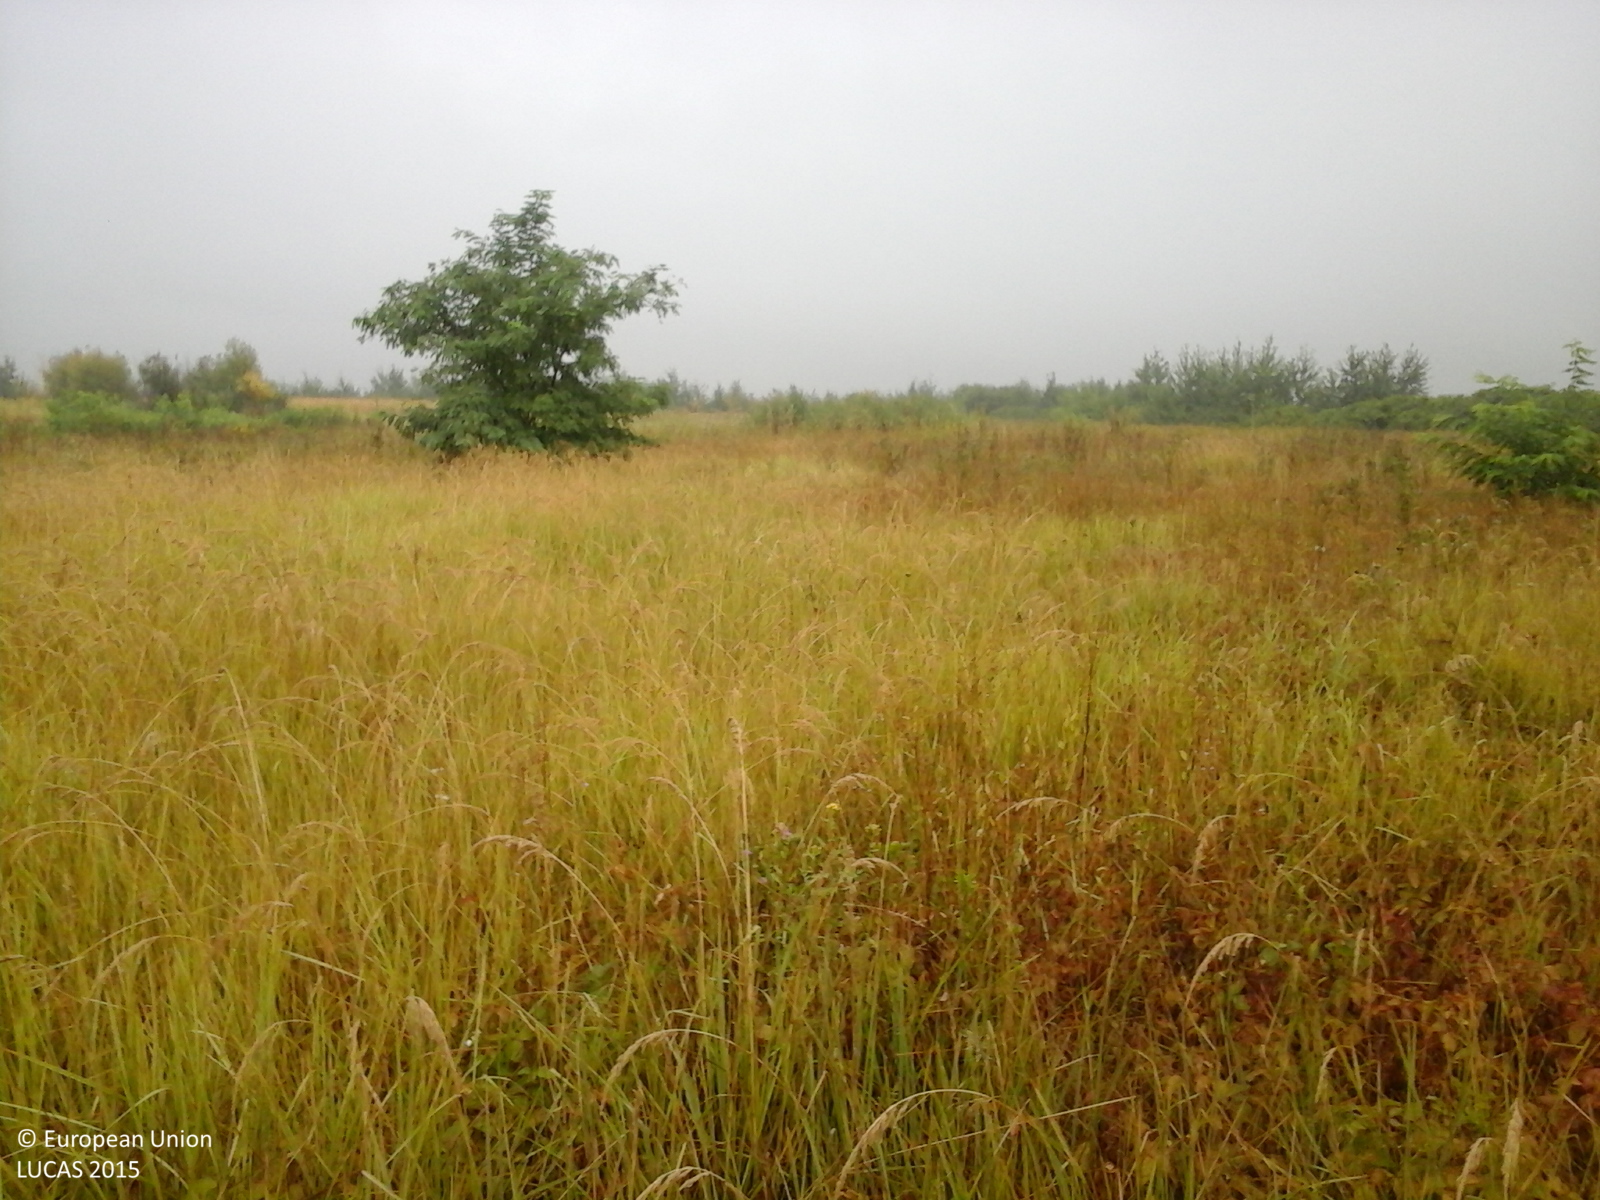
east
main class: Grassland
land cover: Grassland without tree/shrub cover
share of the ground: > 75 %
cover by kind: herbaceous plants 100 %
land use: Agriculture (excluding fallow land and kitchen gardens)
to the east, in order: Grassland without tree/shrub cover; Spontaneously vegetated surfaces; Common wheat; Spontaneously vegetated surfaces; Broadleaved woodland
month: August
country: RO
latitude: 45.7088
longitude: 21.3483
